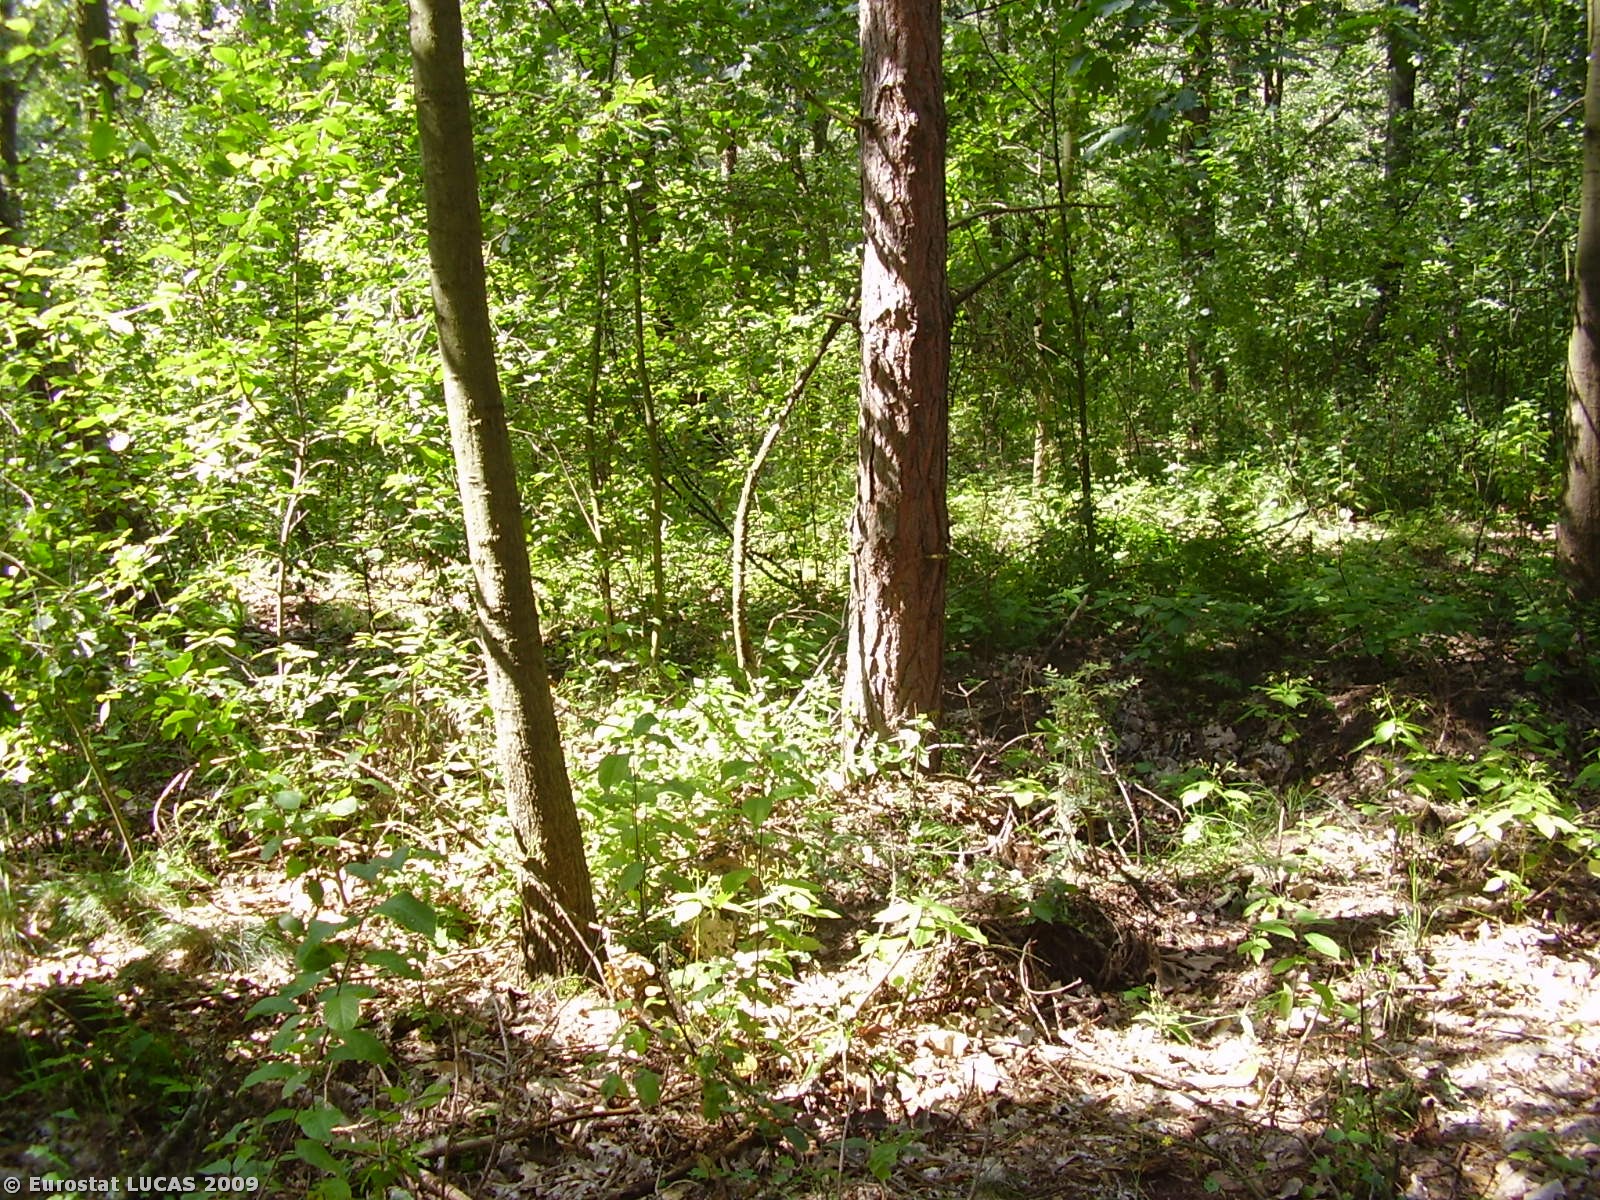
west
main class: Woodland
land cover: Mixed woodland
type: hemiboreal forest and nemoral coniferous forest and mixed broadleaved-coniferous forest
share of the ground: > 75 %
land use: Unused
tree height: > 5 m
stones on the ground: < 10 %
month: August
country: PL
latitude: 51.4837
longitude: 17.0232
